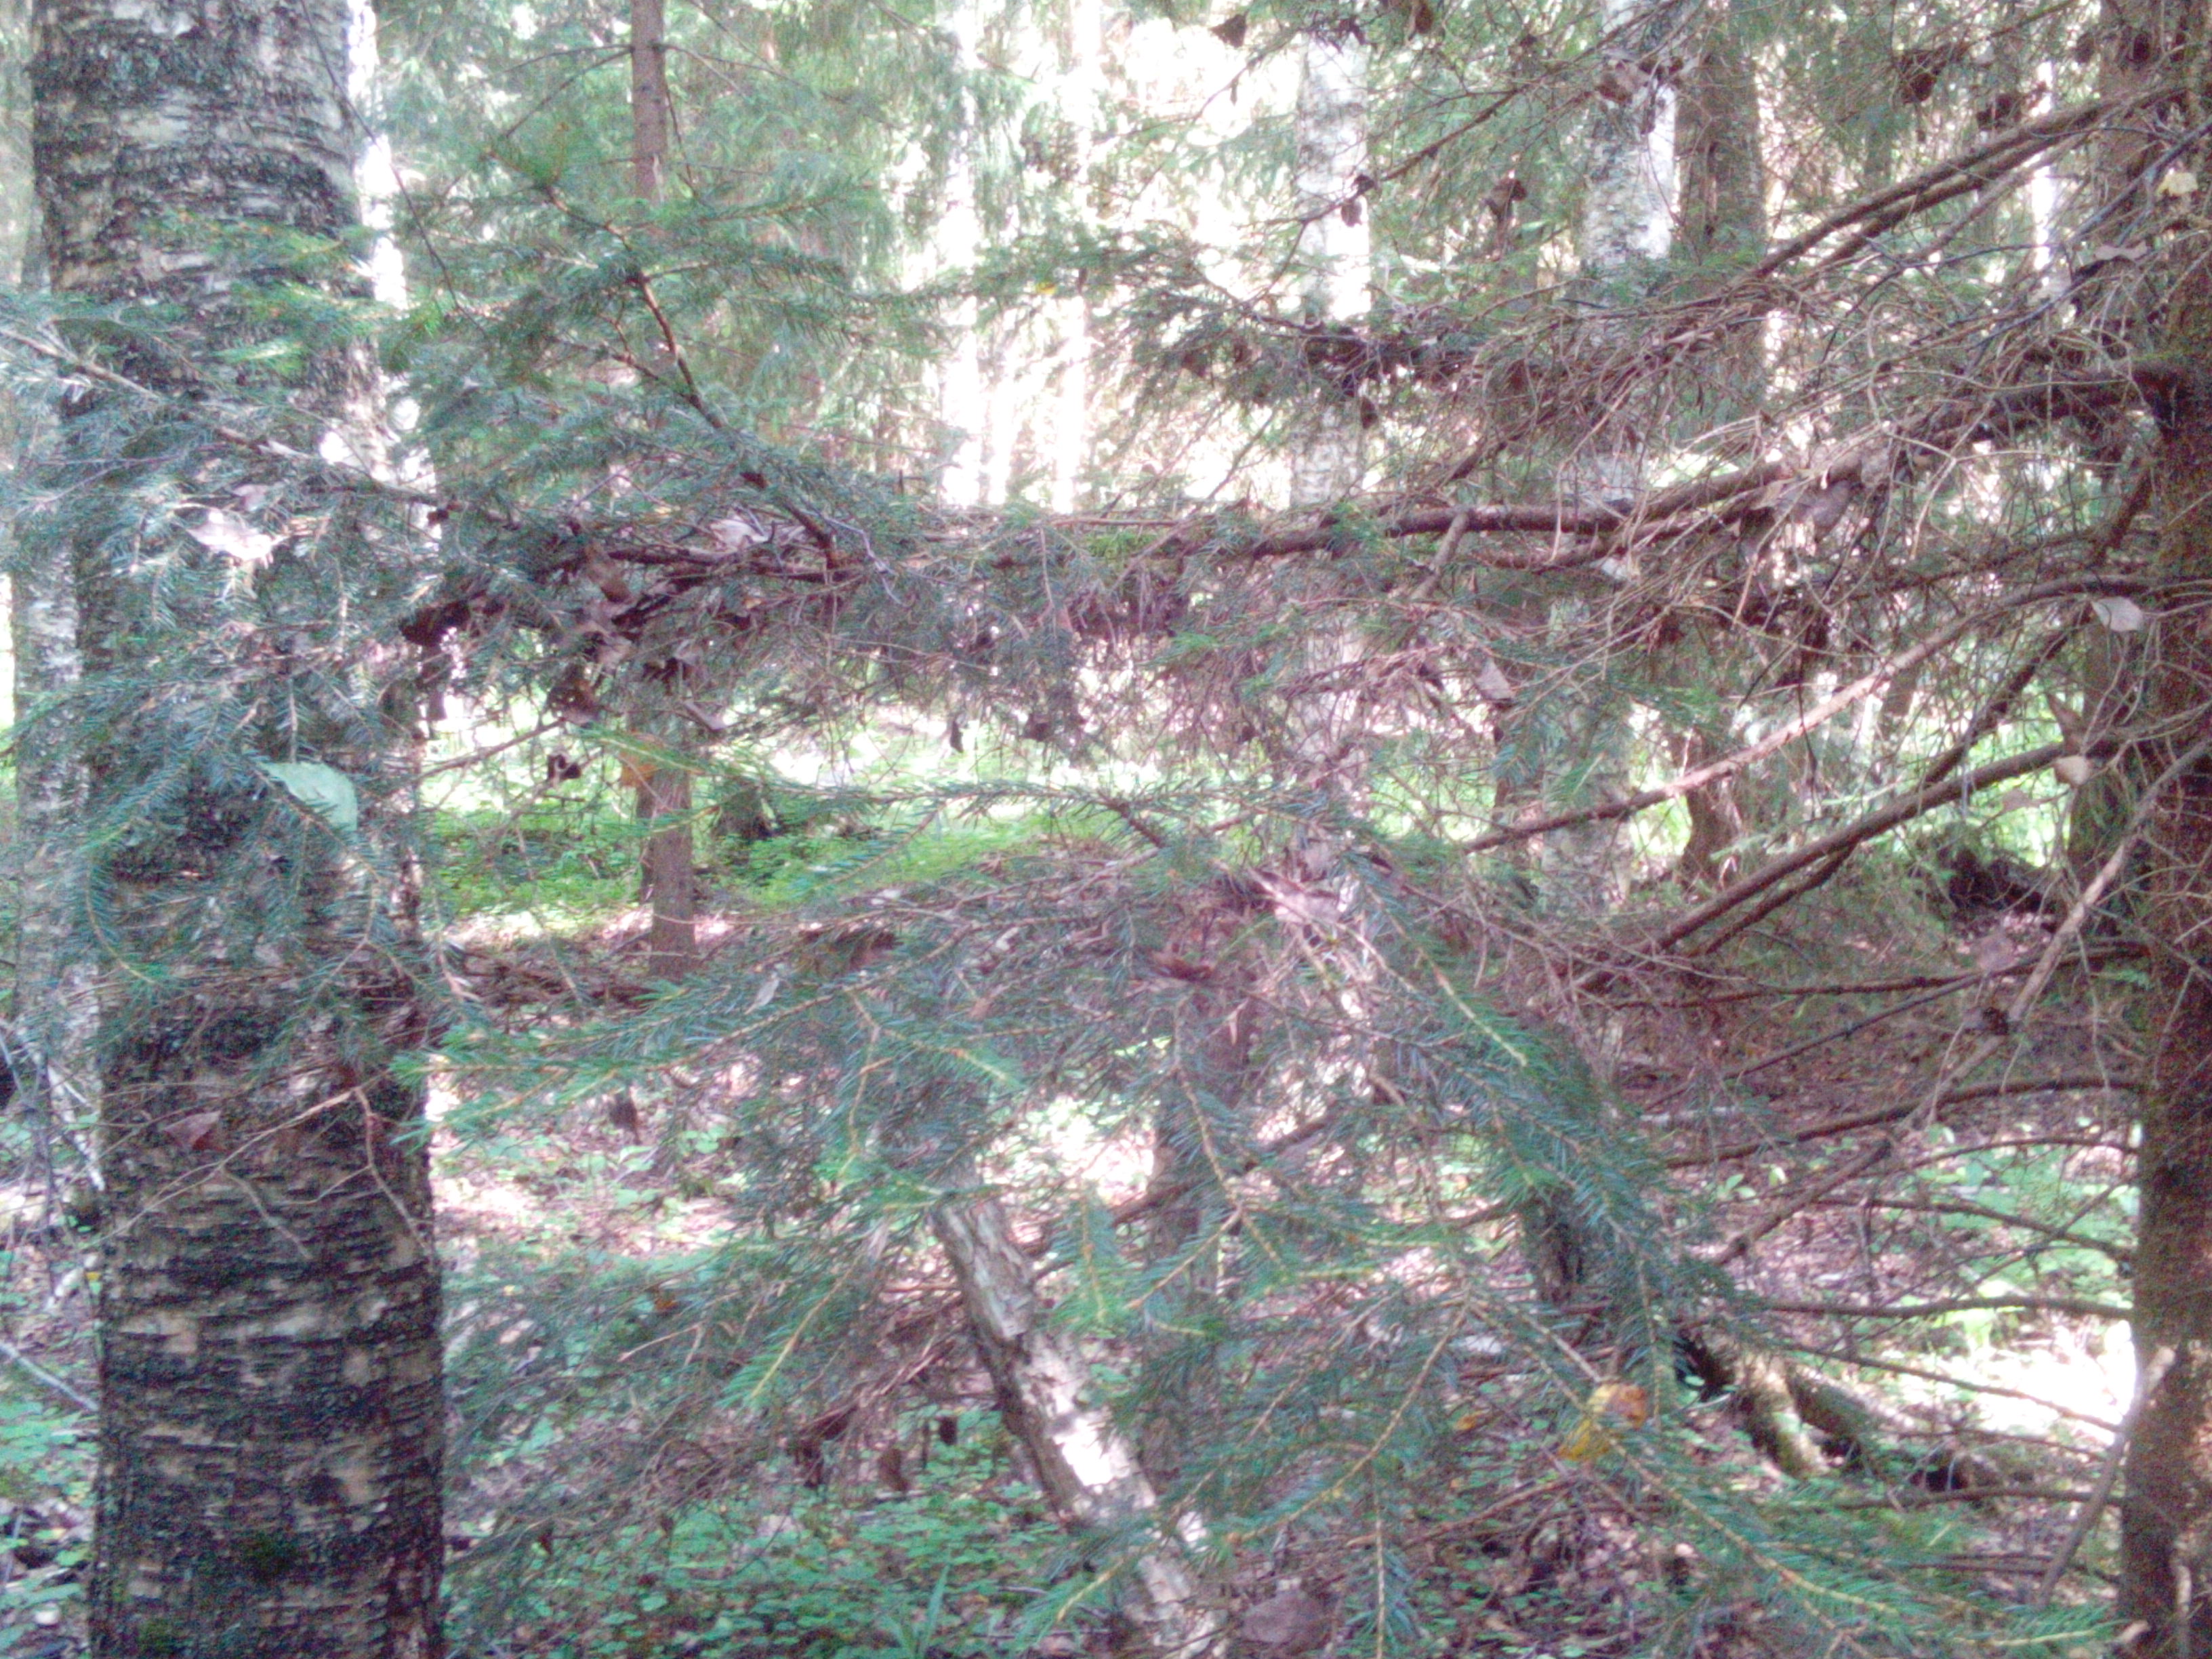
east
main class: Woodland
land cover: Spruce dominated mixed woodland
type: hemiboreal forest and nemoral coniferous forest and mixed broadleaved-coniferous forest
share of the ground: > 75 %
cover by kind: coniferous forest trees 40 %, broadleaved forest trees 40 %, herbaceous plants 10 %, unconsolidated bare surface 10 %
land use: Forestry
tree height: > 5 m
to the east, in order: Spruce dominated mixed woodland; Spruce dominated coniferous woodland; Ditches and canals; Spruce dominated mixed woodland
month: July
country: LV
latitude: 56.7734
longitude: 21.3462
